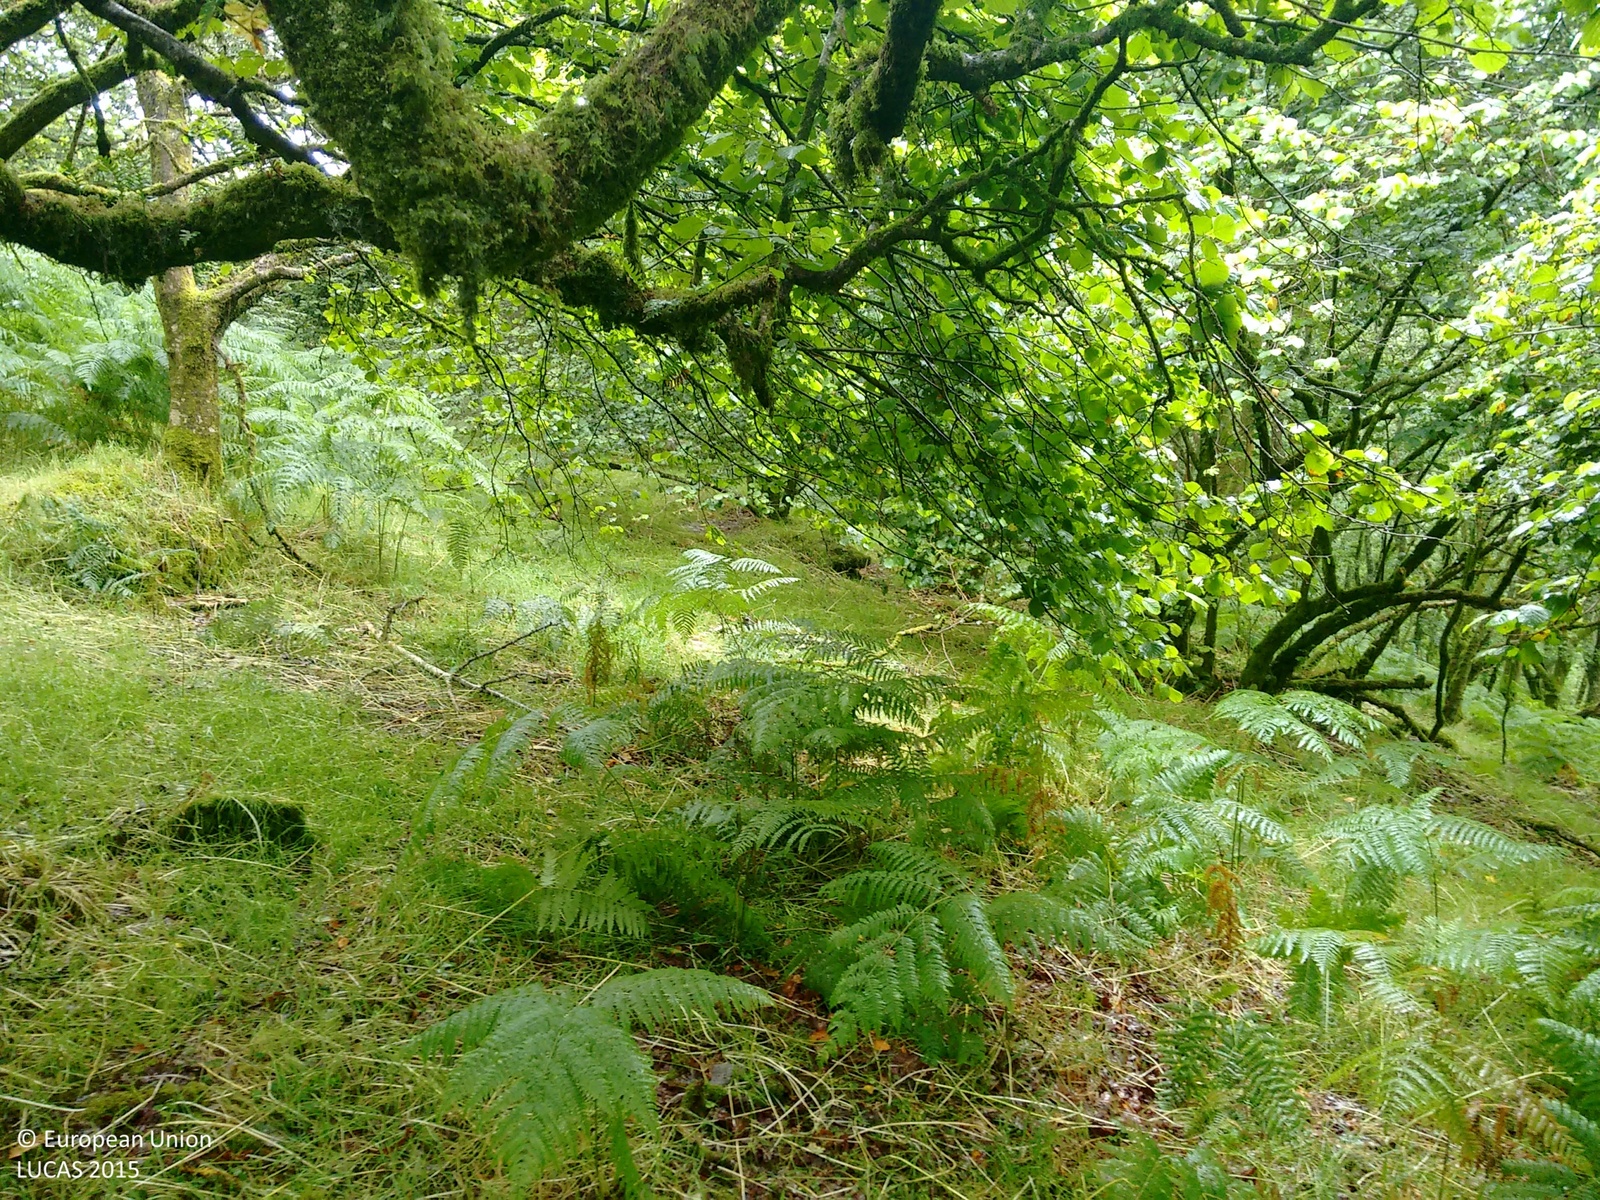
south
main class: Woodland
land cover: Broadleaved woodland
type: acidophilous oak and oak-birch forest
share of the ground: > 75 %
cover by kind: broadleaved forest trees 100 %
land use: Semi-natural and natural areas not in use
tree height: > 5 m
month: August
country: GB
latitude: 50.5498
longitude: -4.0528
